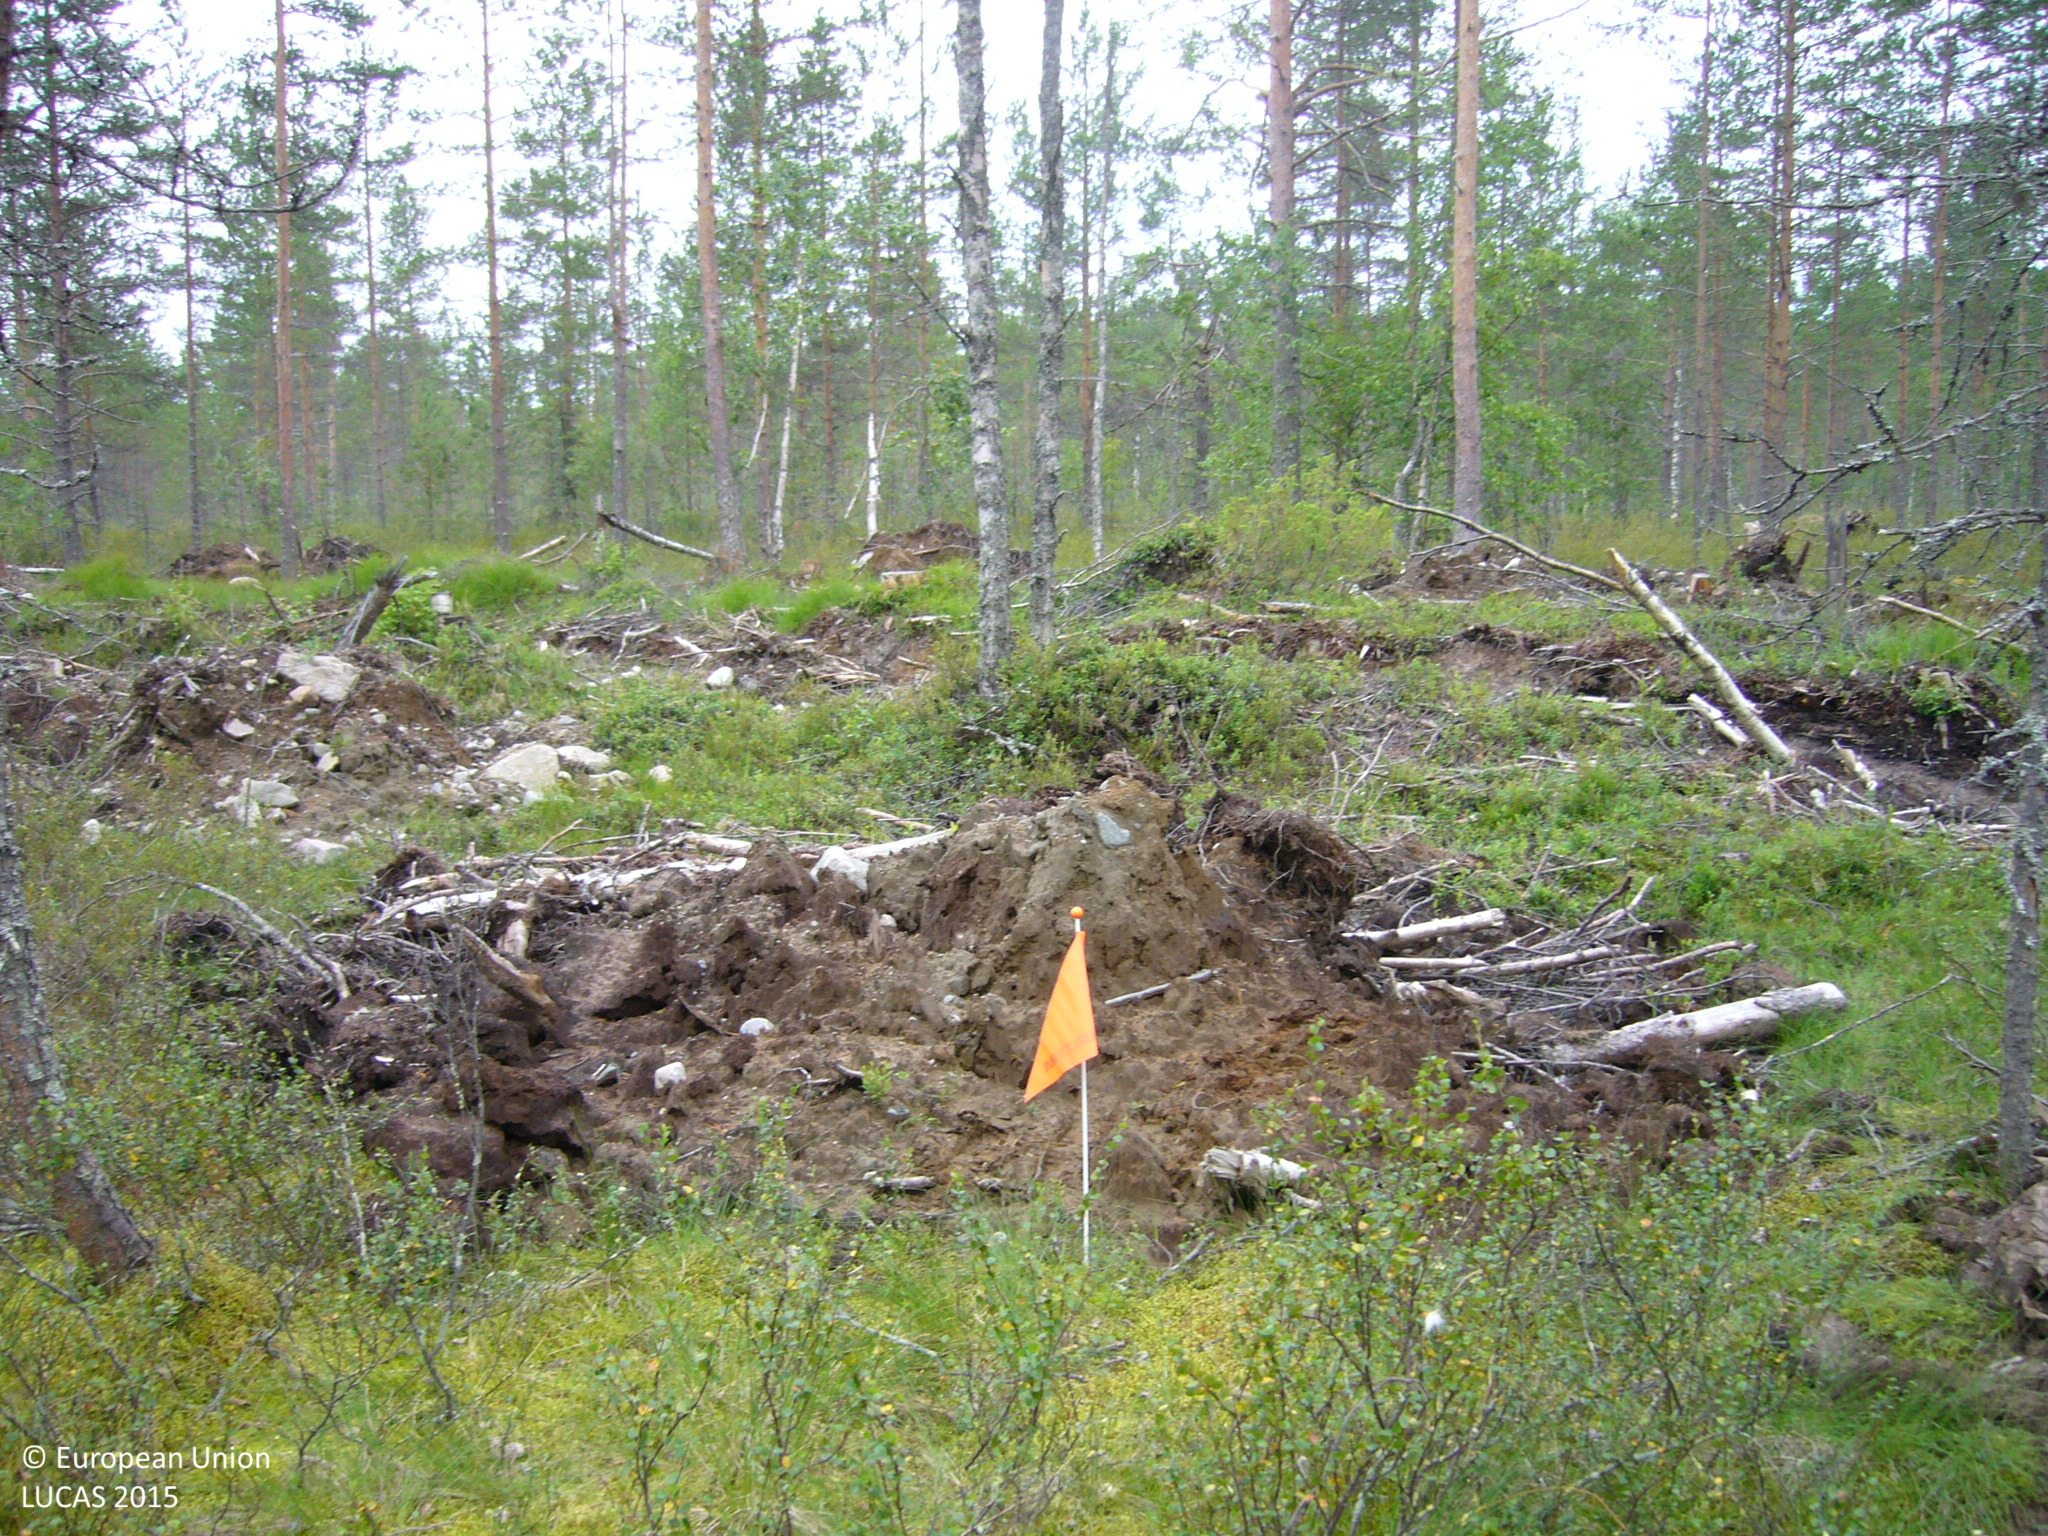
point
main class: Woodland
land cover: Pine dominated mixed woodland
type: boreal forest
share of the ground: 50 - 75 %
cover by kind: broadleaved forest trees 30 %, shrubs 30 %, coniferous forest trees 25 %, unconsolidated bare surface 10 %
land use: Forestry
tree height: > 5 m
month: July
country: FI
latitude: 63.9594
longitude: 26.5998
